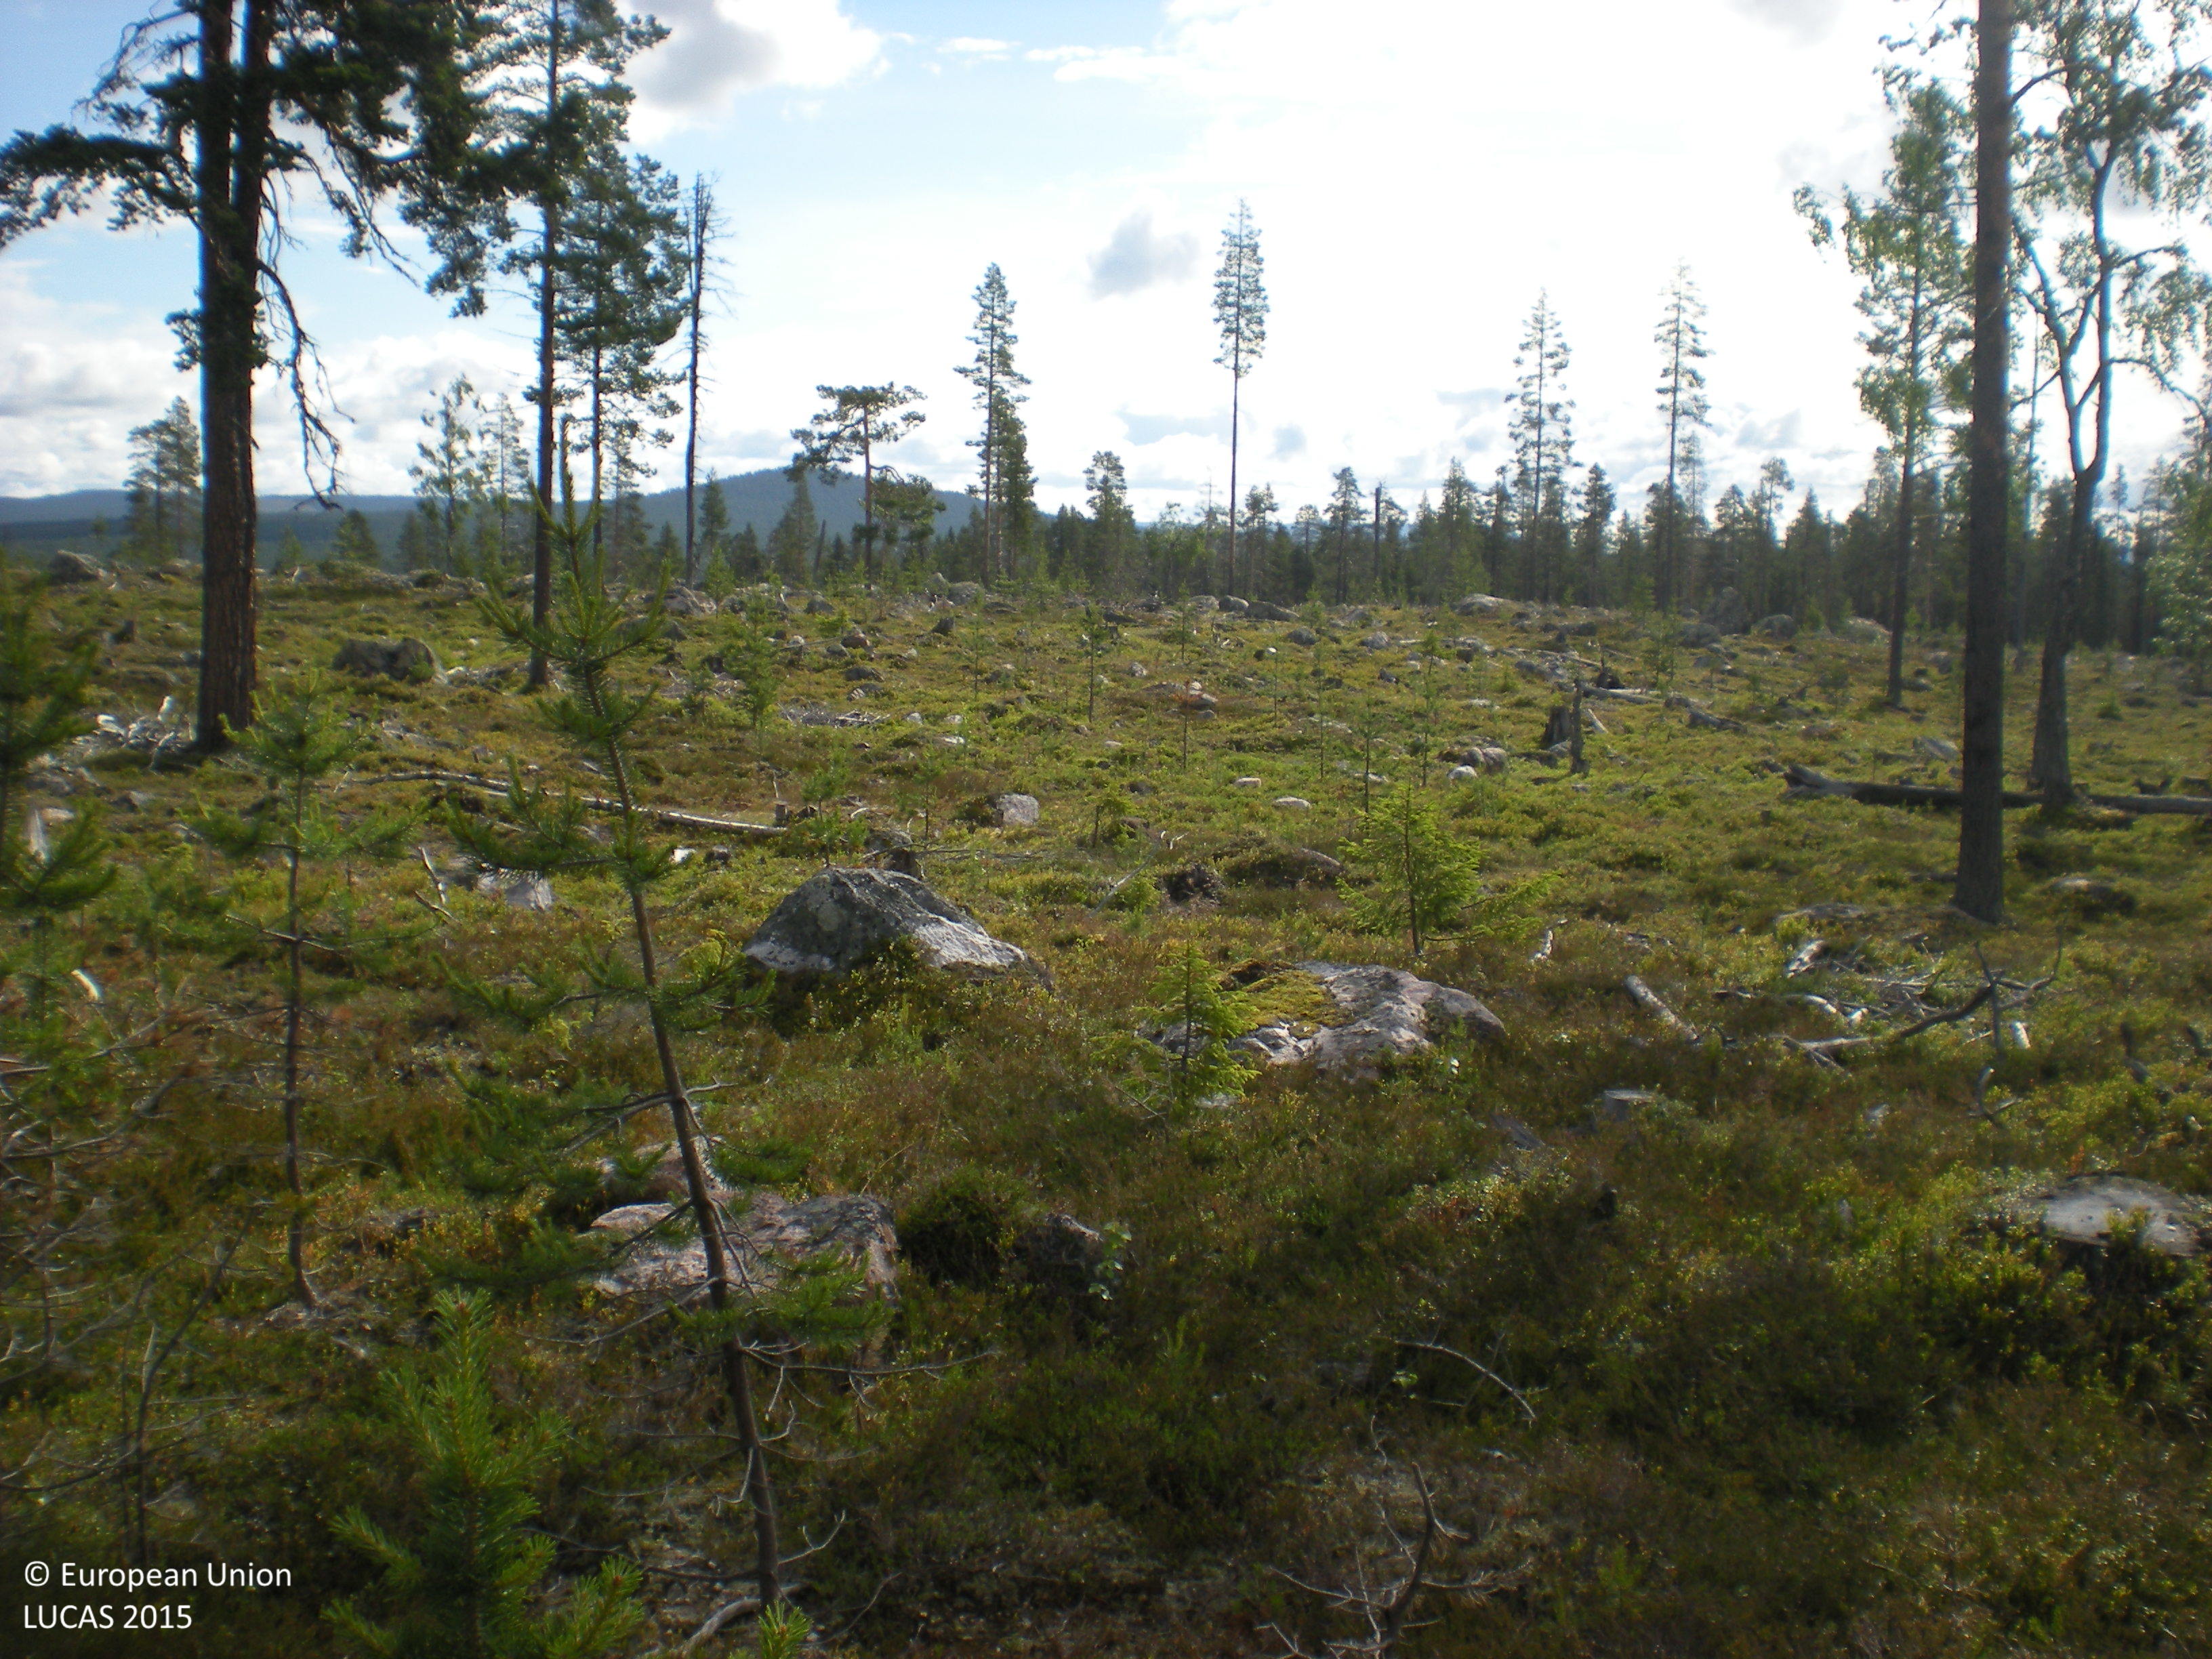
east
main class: Woodland
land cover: Pine dominated coniferous woodland
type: boreal forest
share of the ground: 10 - 25 %
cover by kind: shrubs 60 %, lichens and mosses 20 %, coniferous forest trees 10 %, consolidated bare surface 10 %
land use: Forestry
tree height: > 5 m
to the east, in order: Pine dominated coniferous woodland
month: July
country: SE
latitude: 65.8000
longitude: 18.2868
